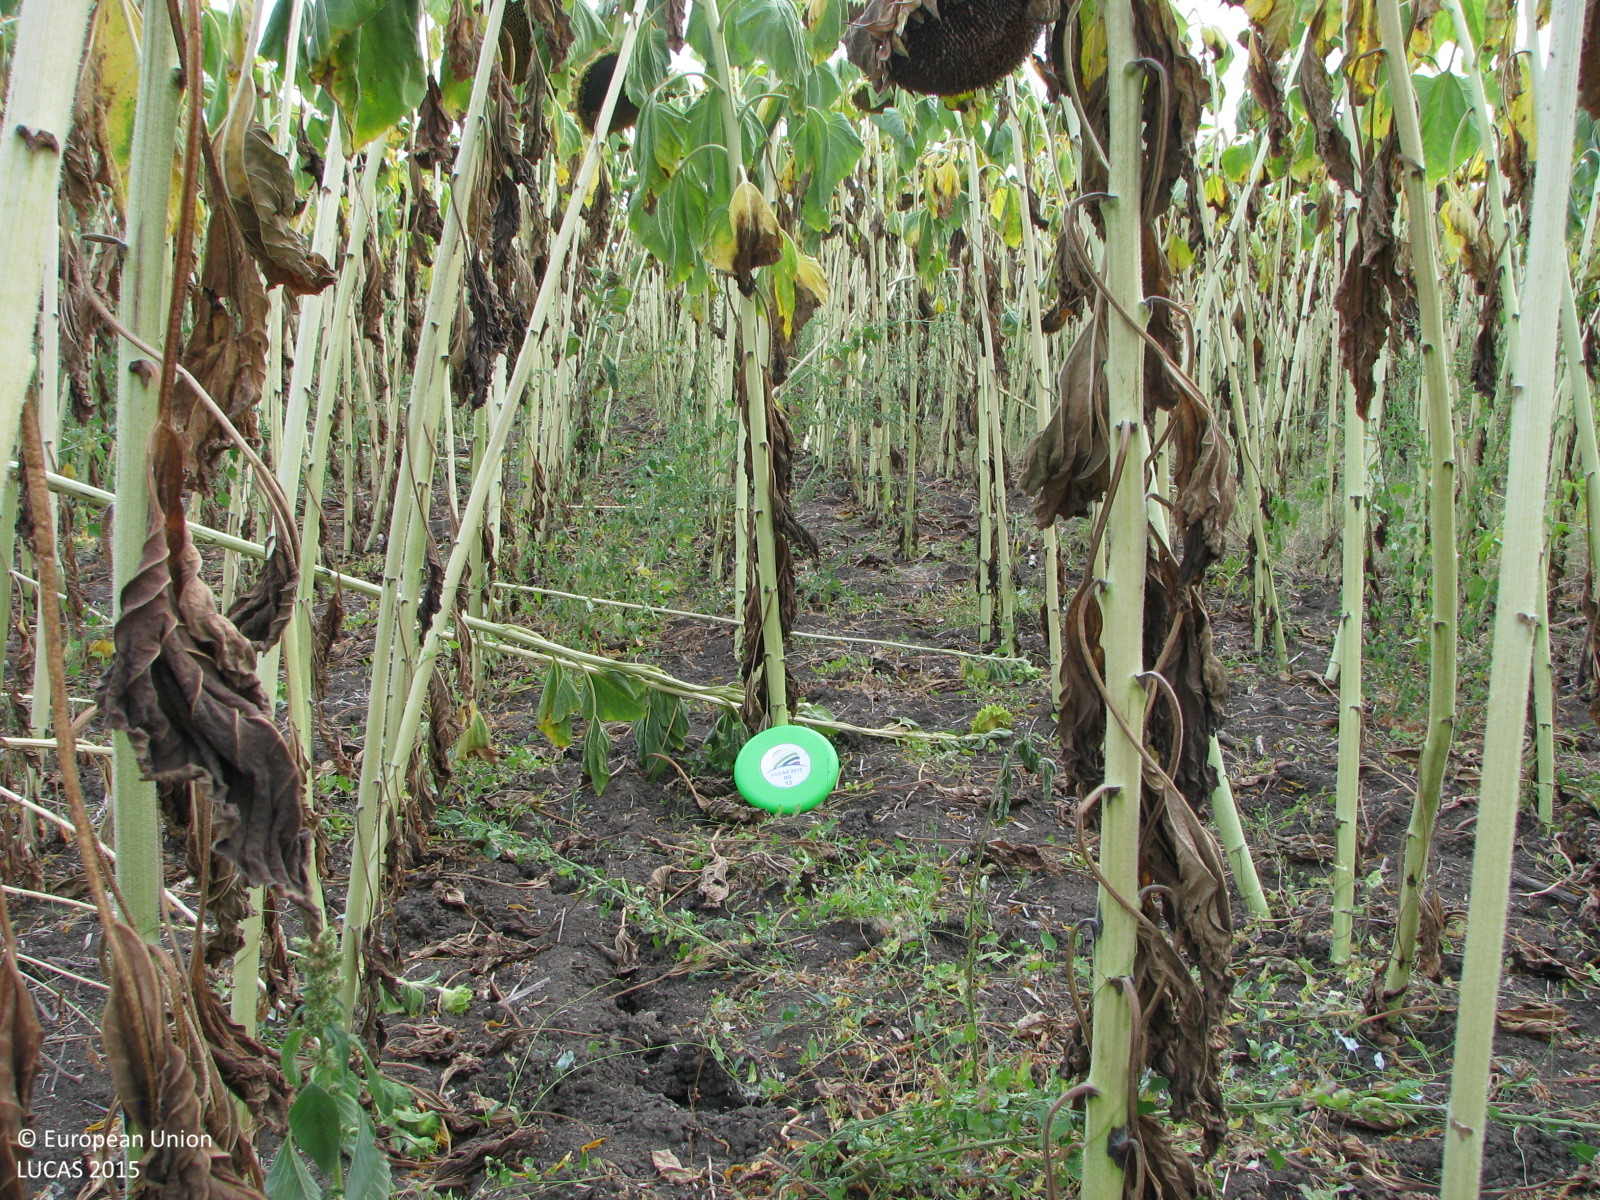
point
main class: Cropland
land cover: Sunflower
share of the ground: > 75 %
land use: Agriculture (excluding fallow land and kitchen gardens)
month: August
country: BG
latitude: 42.4027
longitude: 26.5552
